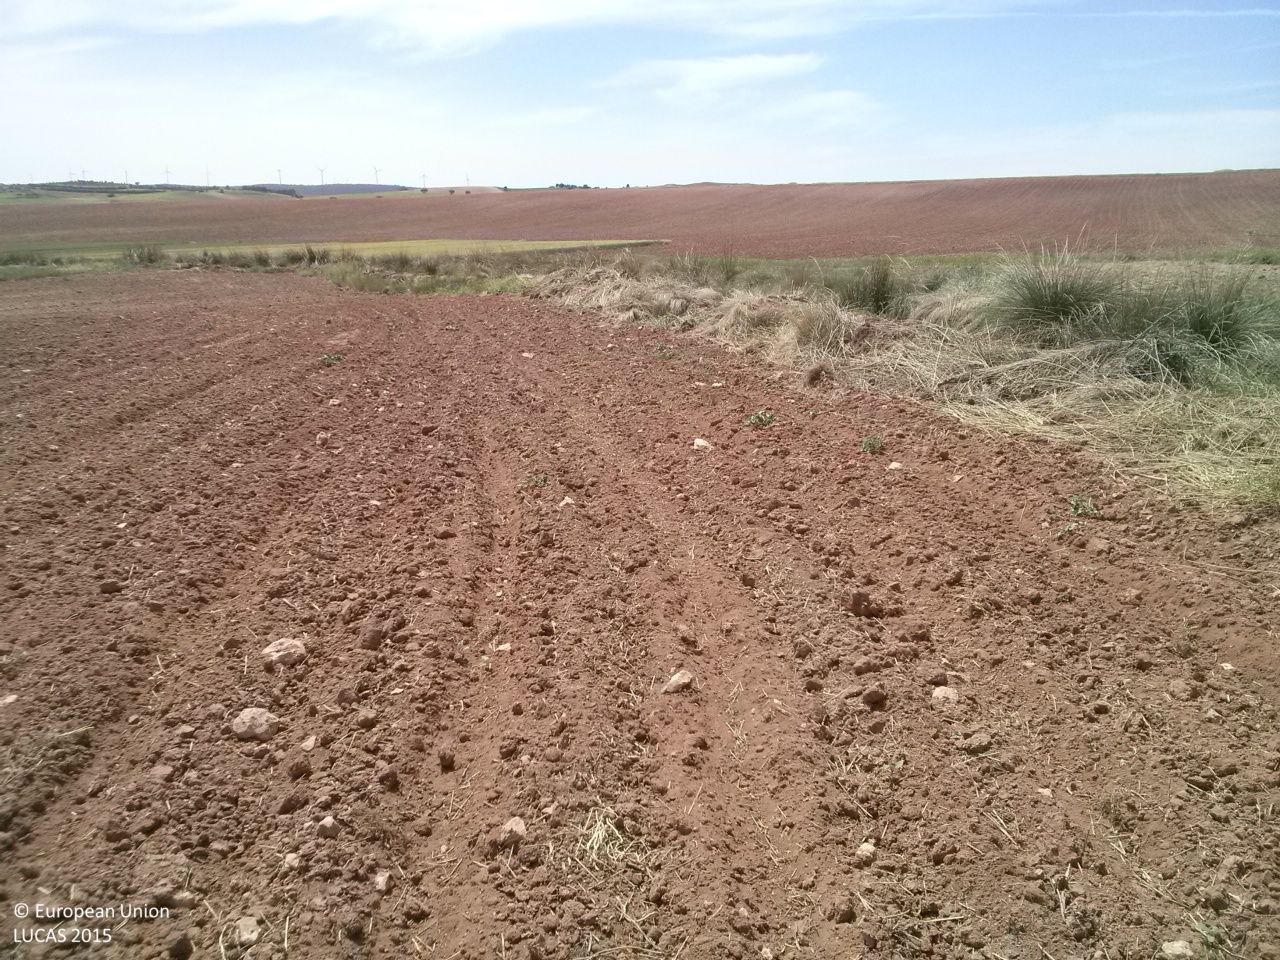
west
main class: Cropland
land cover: Sunflower
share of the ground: < 10 %
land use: Agriculture (excluding fallow land and kitchen gardens)
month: May
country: ES
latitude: 40.0432
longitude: -2.6908
